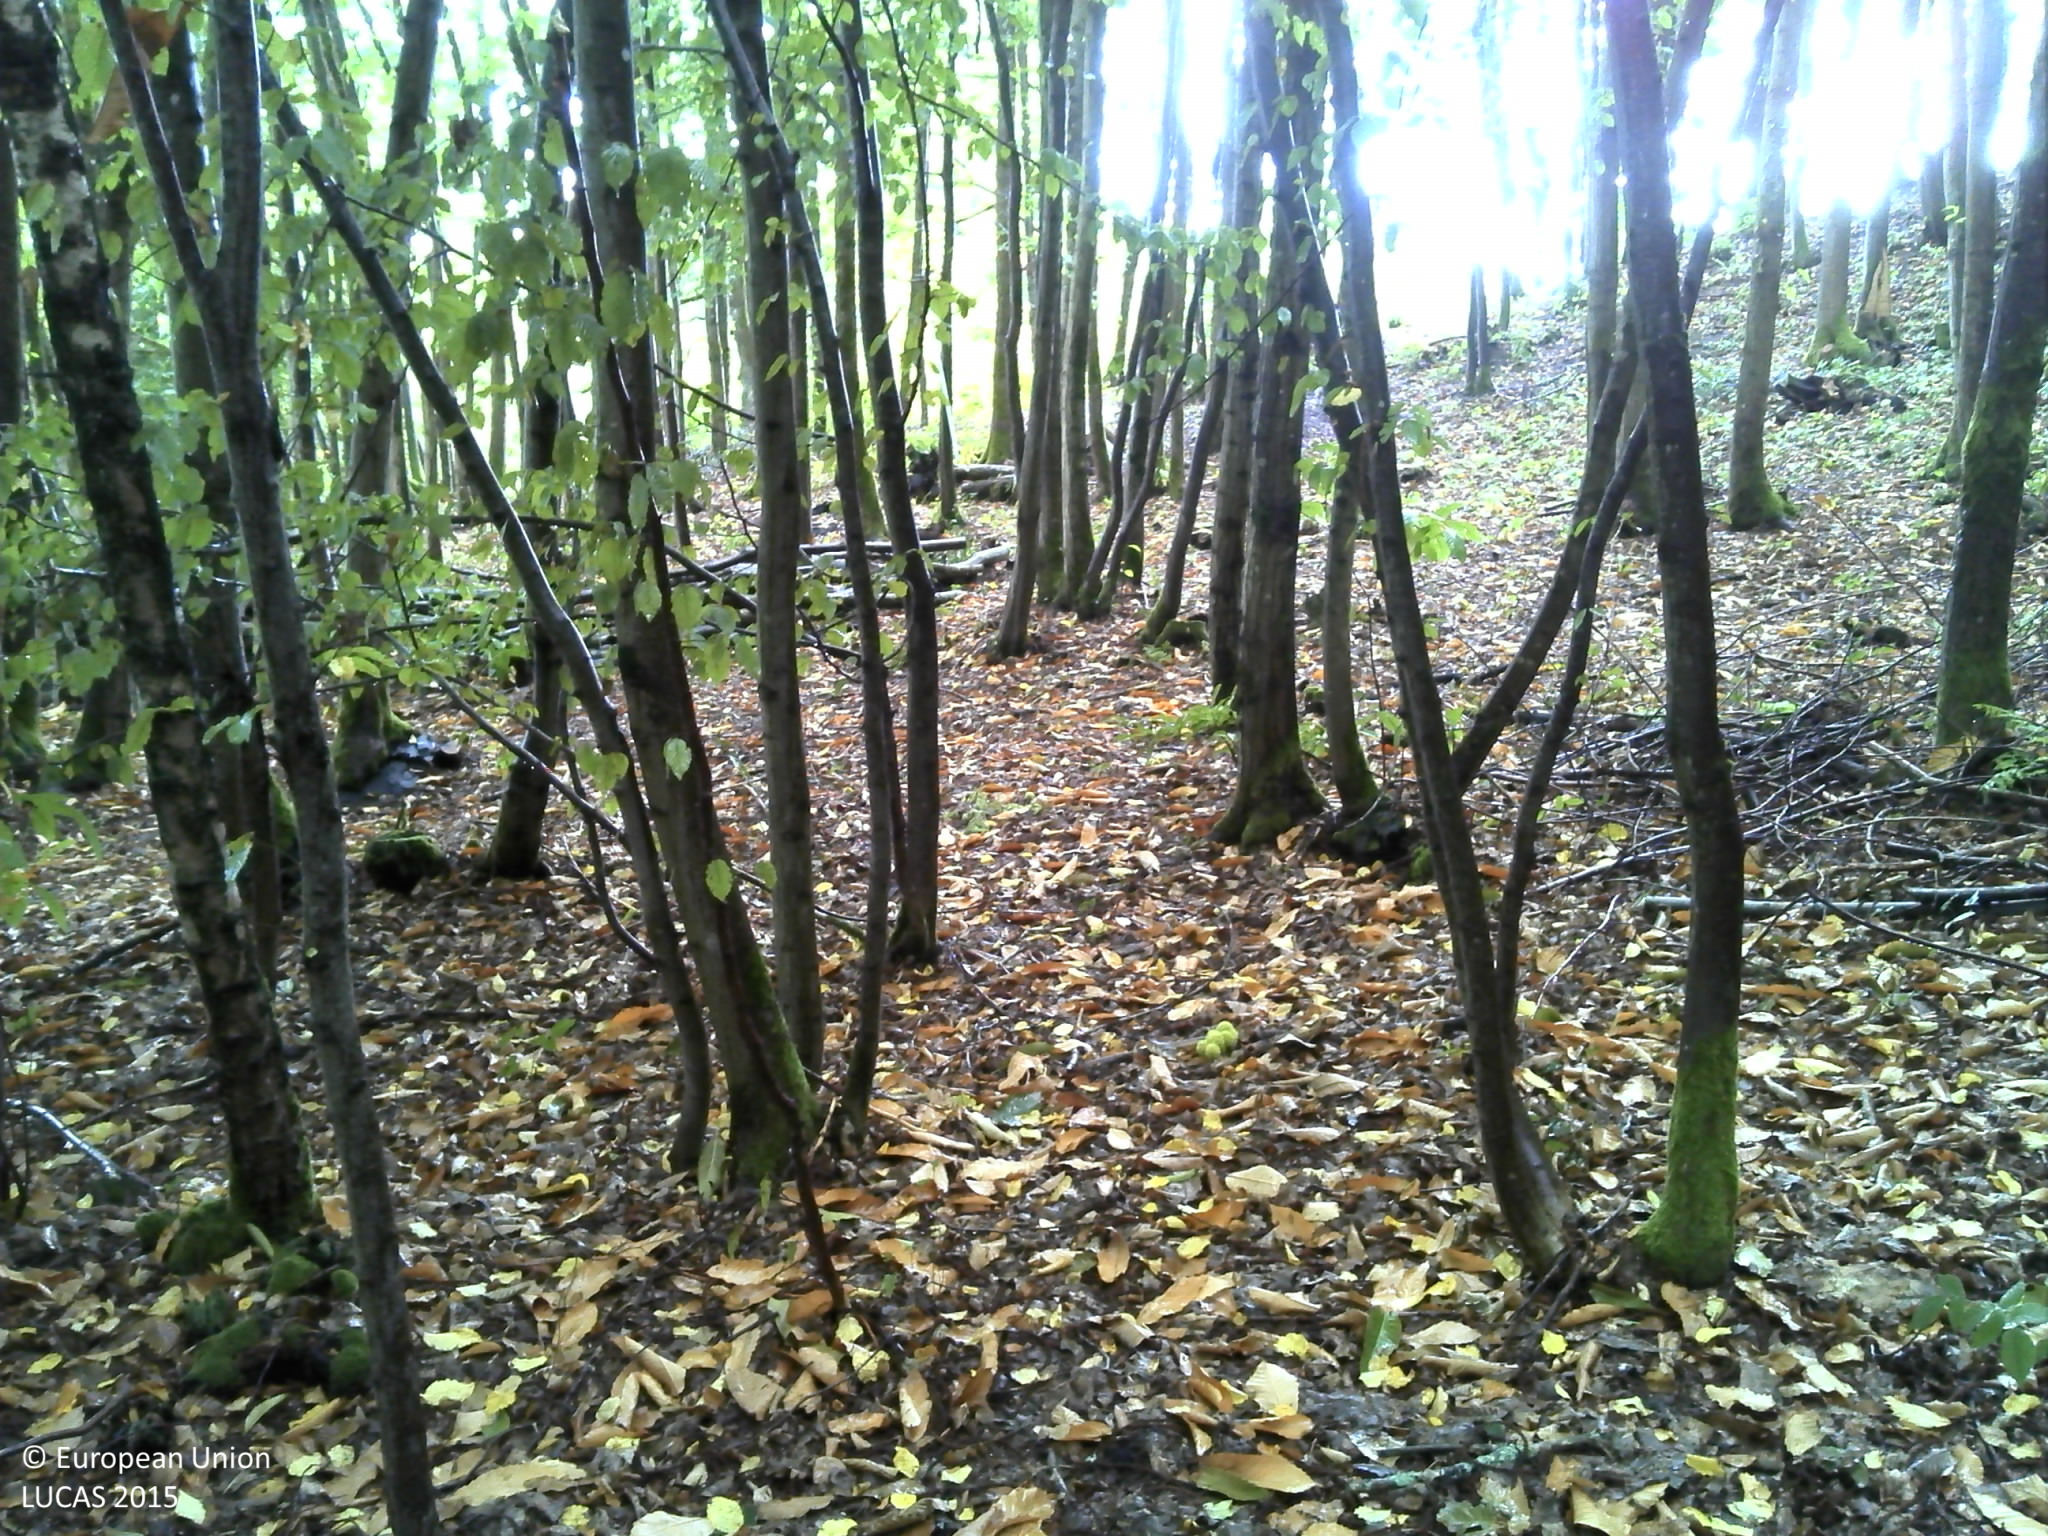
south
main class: Woodland
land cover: Broadleaved woodland
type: mesophytic deciduous forest
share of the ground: > 75 %
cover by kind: broadleaved forest trees 90 %, consolidated bare surface 10 %
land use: Forestry
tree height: > 5 m
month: September
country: FR
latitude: 48.3523
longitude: 7.2885
